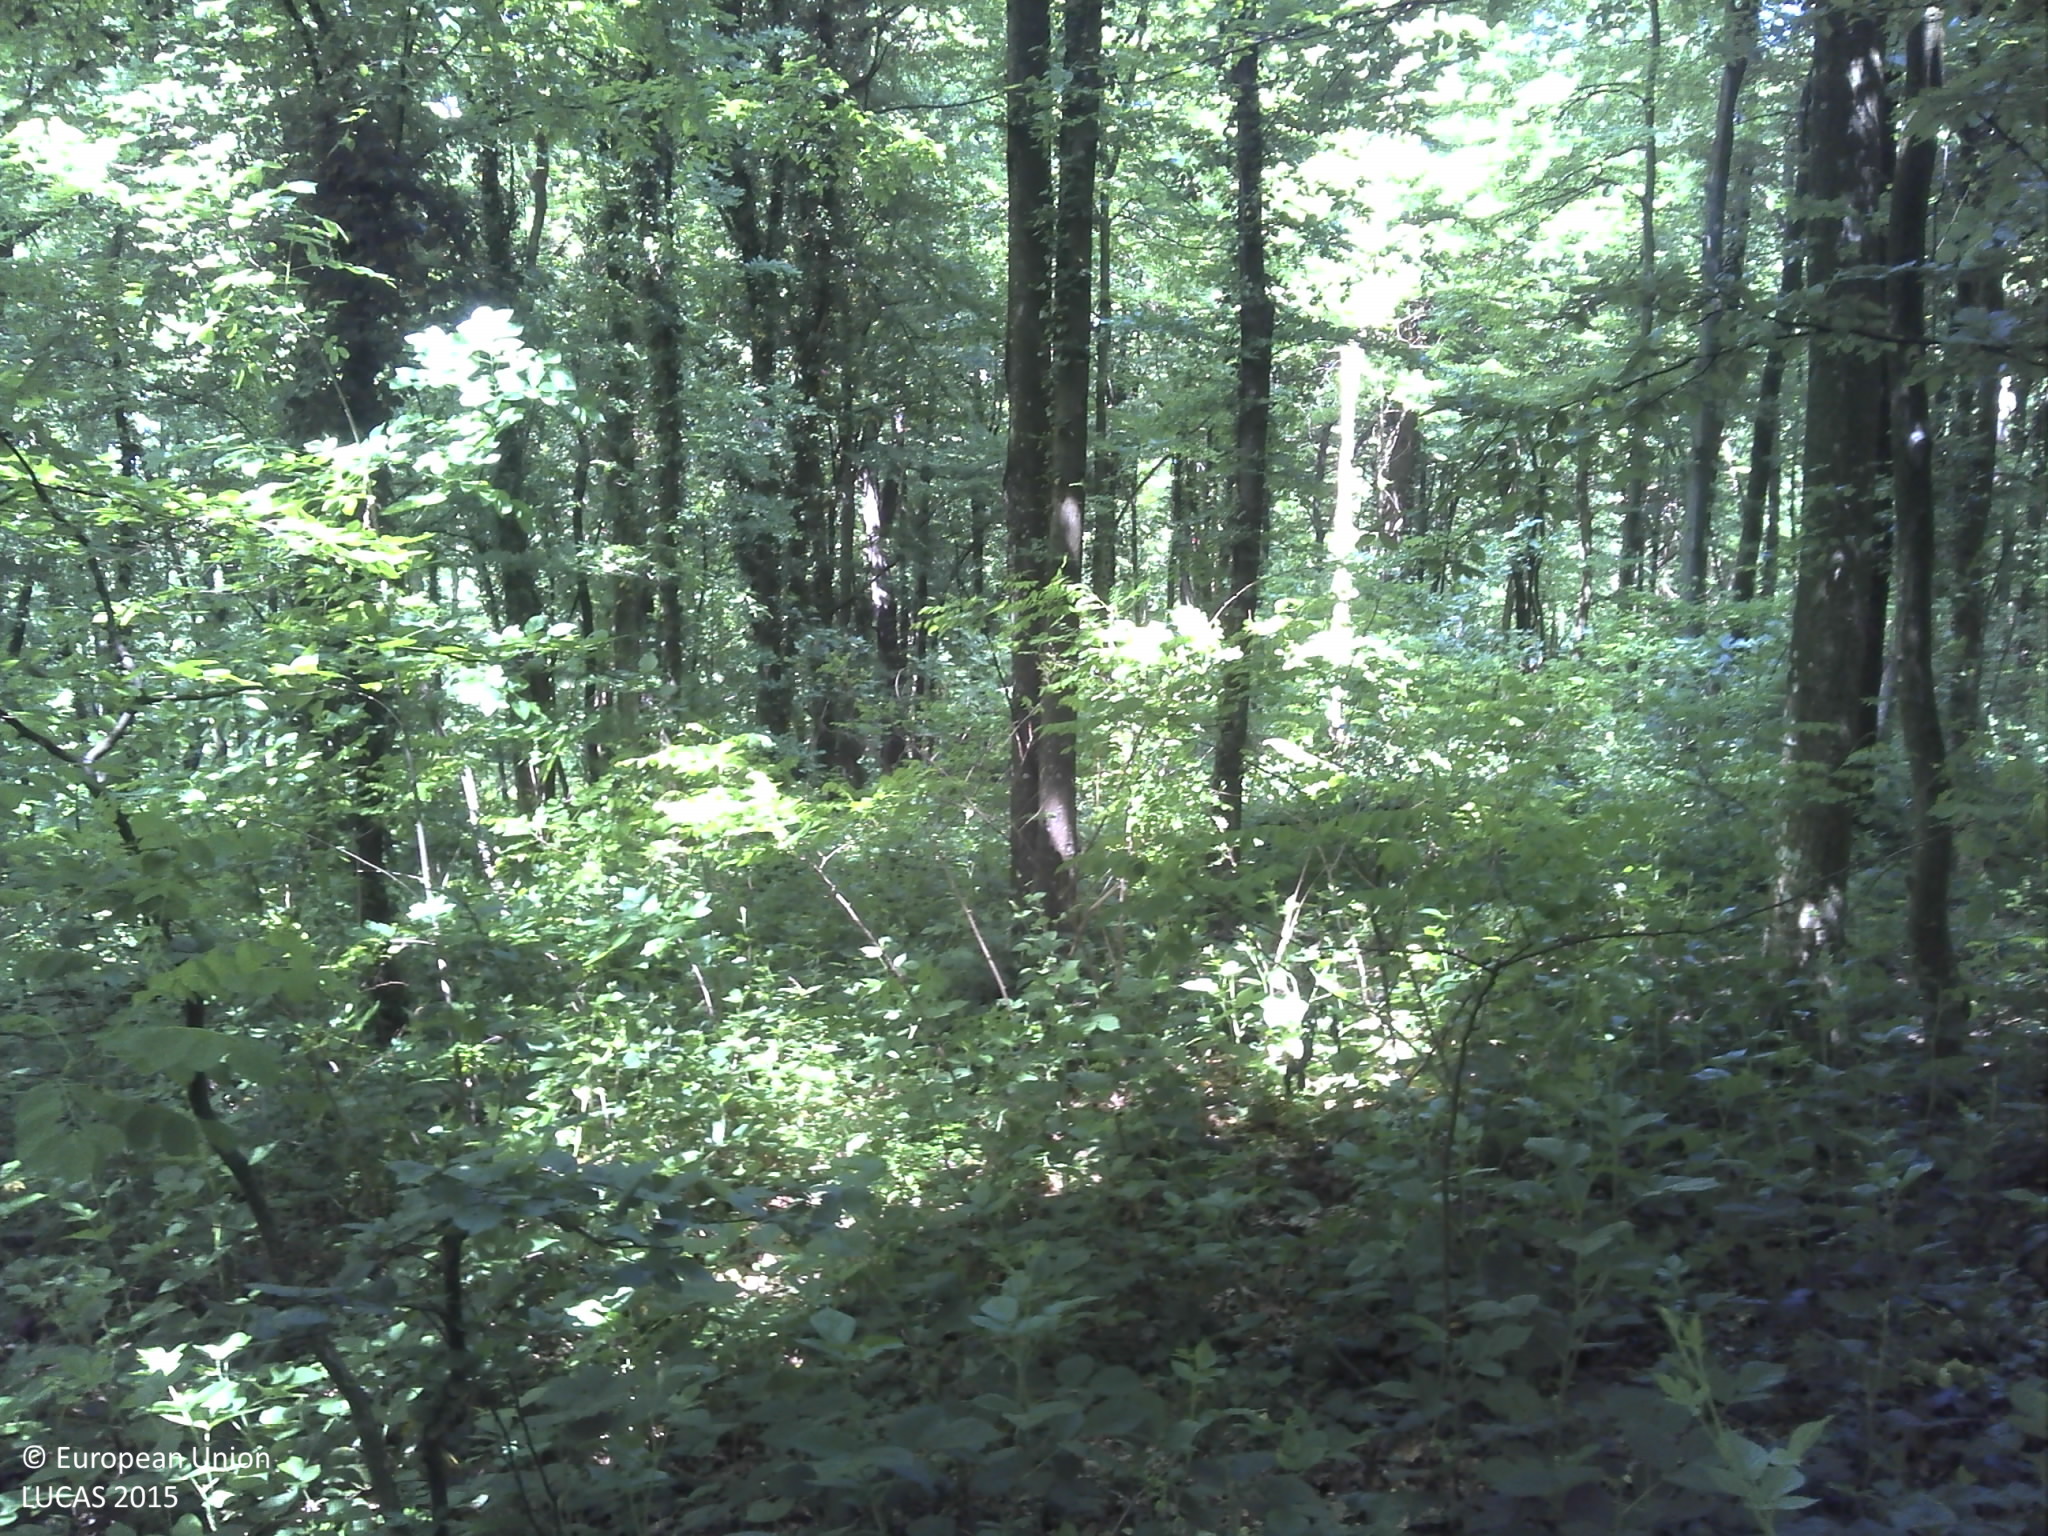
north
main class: Woodland
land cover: Broadleaved woodland
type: acidophilous oak and oak-birch forest
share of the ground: > 75 %
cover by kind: broadleaved forest trees 80 %, lichens and mosses 20 %
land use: Forestry
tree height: > 5 m
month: May
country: HR
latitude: 45.2716
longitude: 18.2508
